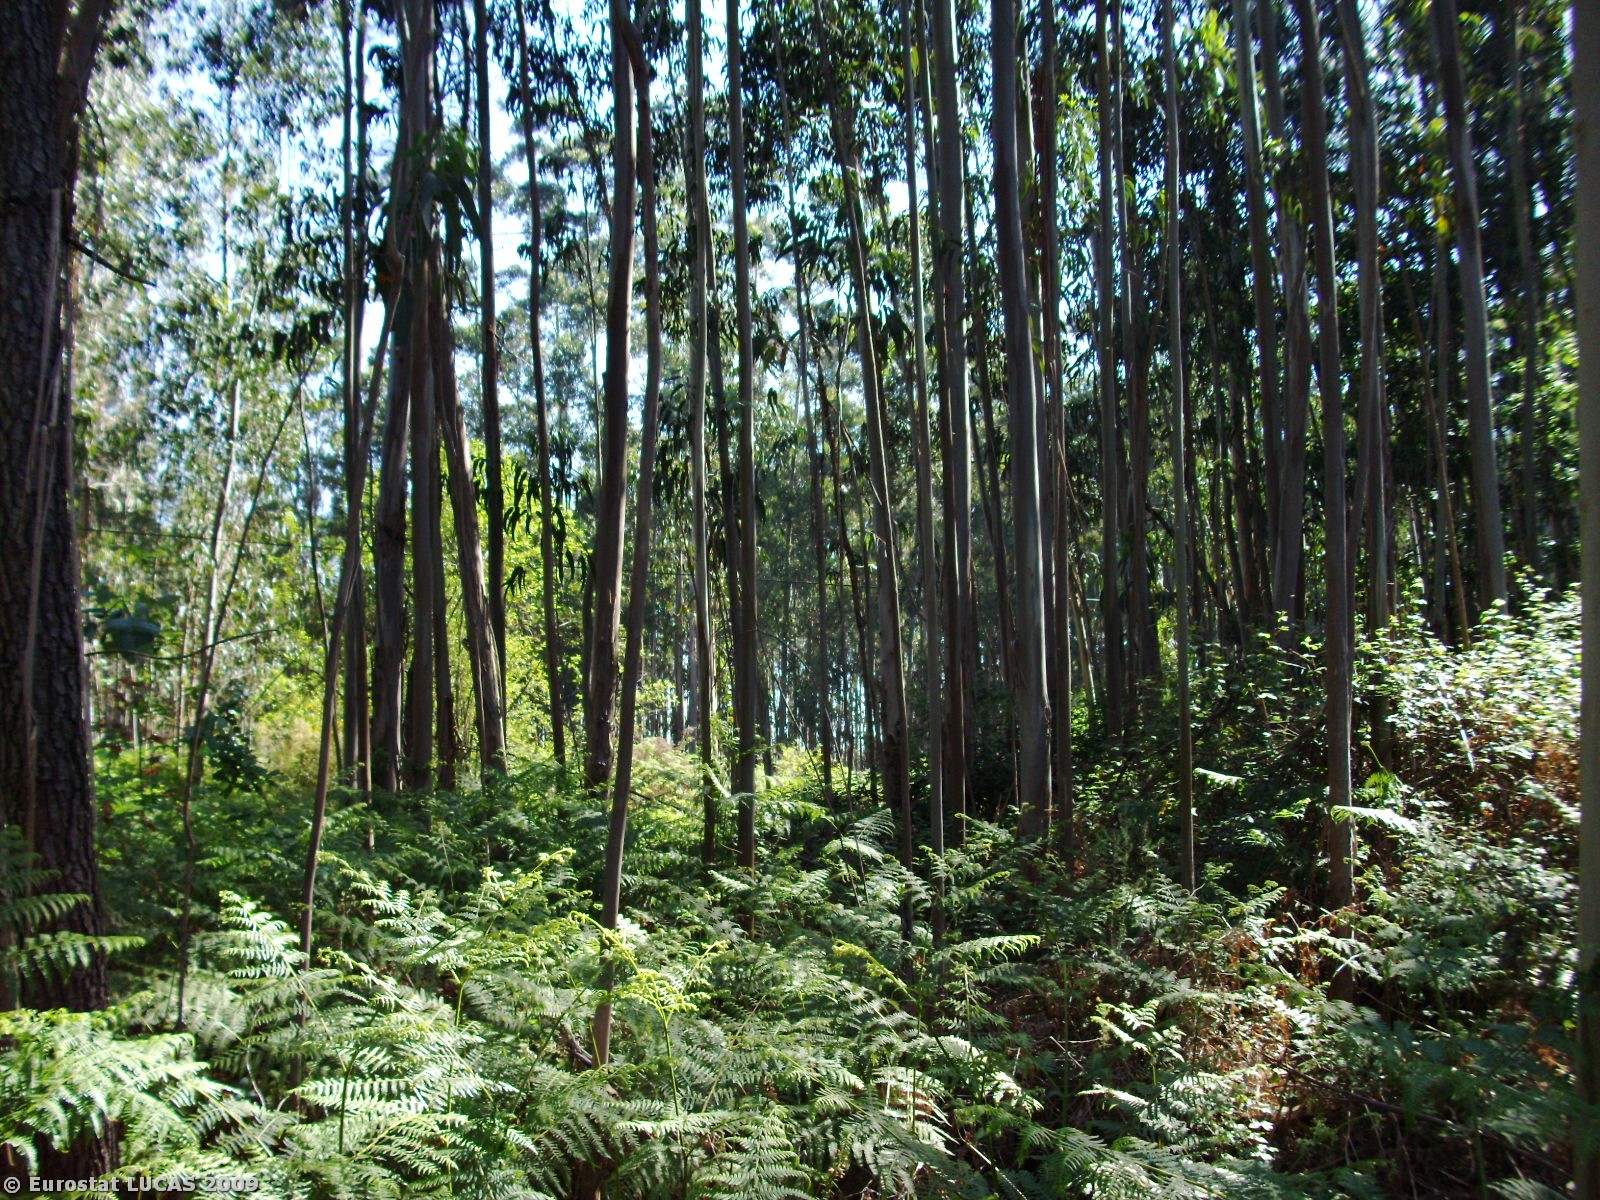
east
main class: Woodland
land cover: Broadleaved woodland
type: plantations and self-sown exotic forest
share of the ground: > 75 %
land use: Forestry
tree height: > 5 m
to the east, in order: Broadleaved woodland; Fences; Electric lines; Grass margins; Paved roads, cycling and walking lanes; Grass margins; Broadleaved woodland
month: May
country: PT
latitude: 40.6708
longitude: -8.4156
